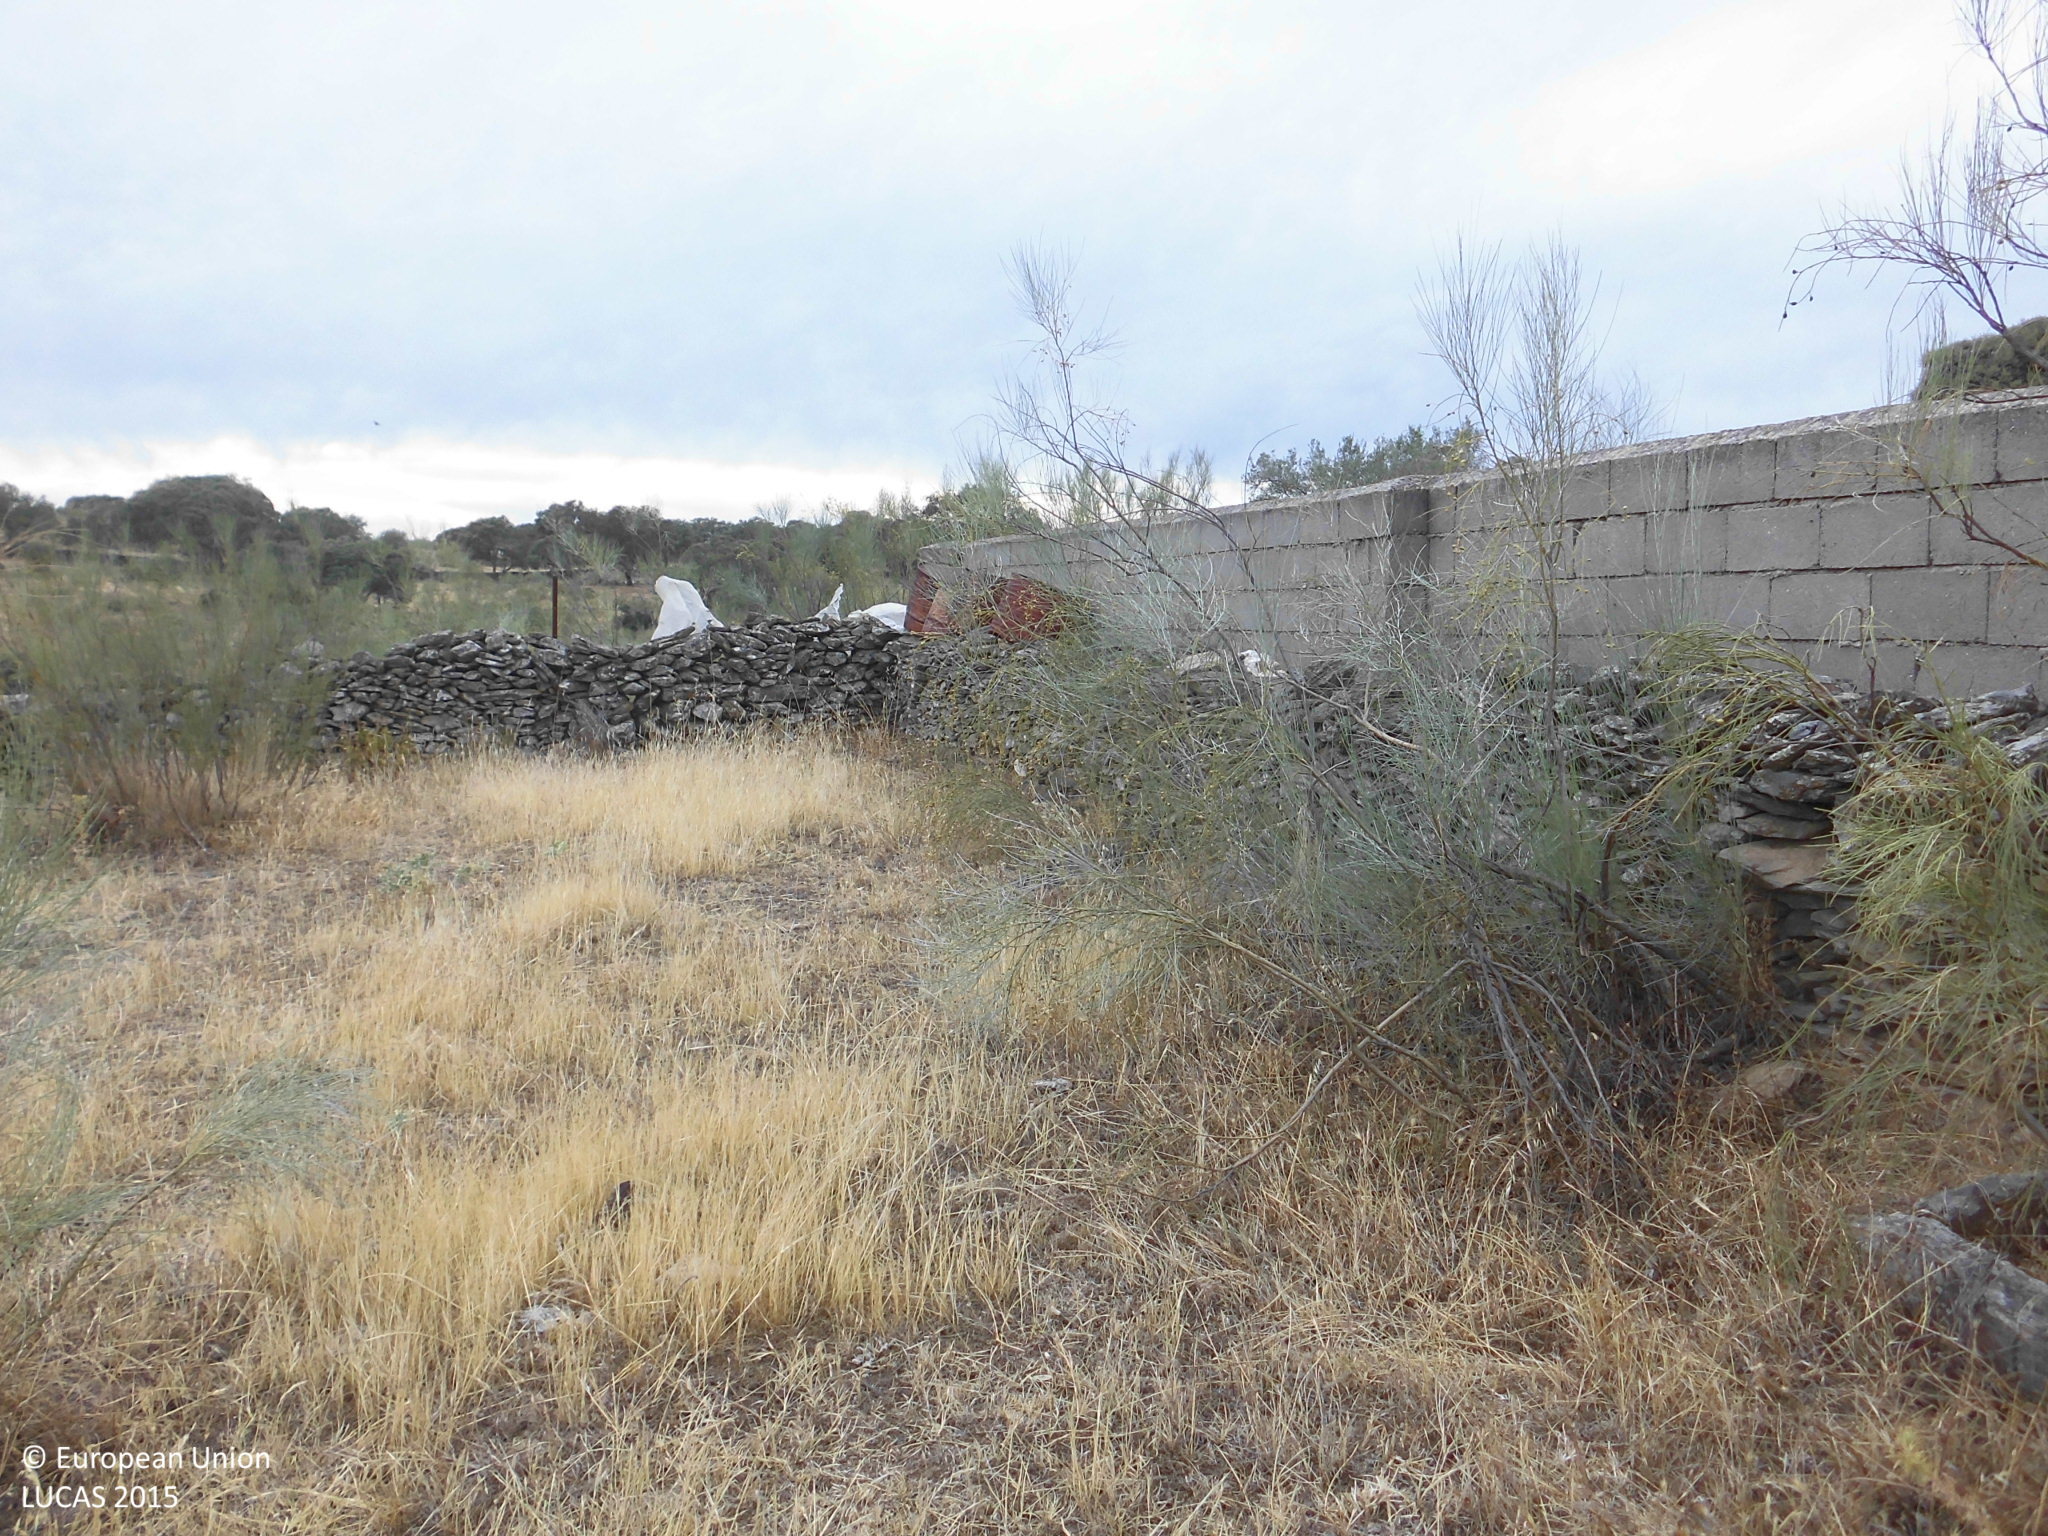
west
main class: Shrubland
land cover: Shrubland without tree cover
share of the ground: 10 - 25 %
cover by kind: herbaceous plants 75 %, shrubs 20 %, consolidated bare surface 5 %
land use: Agriculture (excluding fallow land and kitchen gardens)
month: July
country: ES
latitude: 39.8934
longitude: -6.4856
